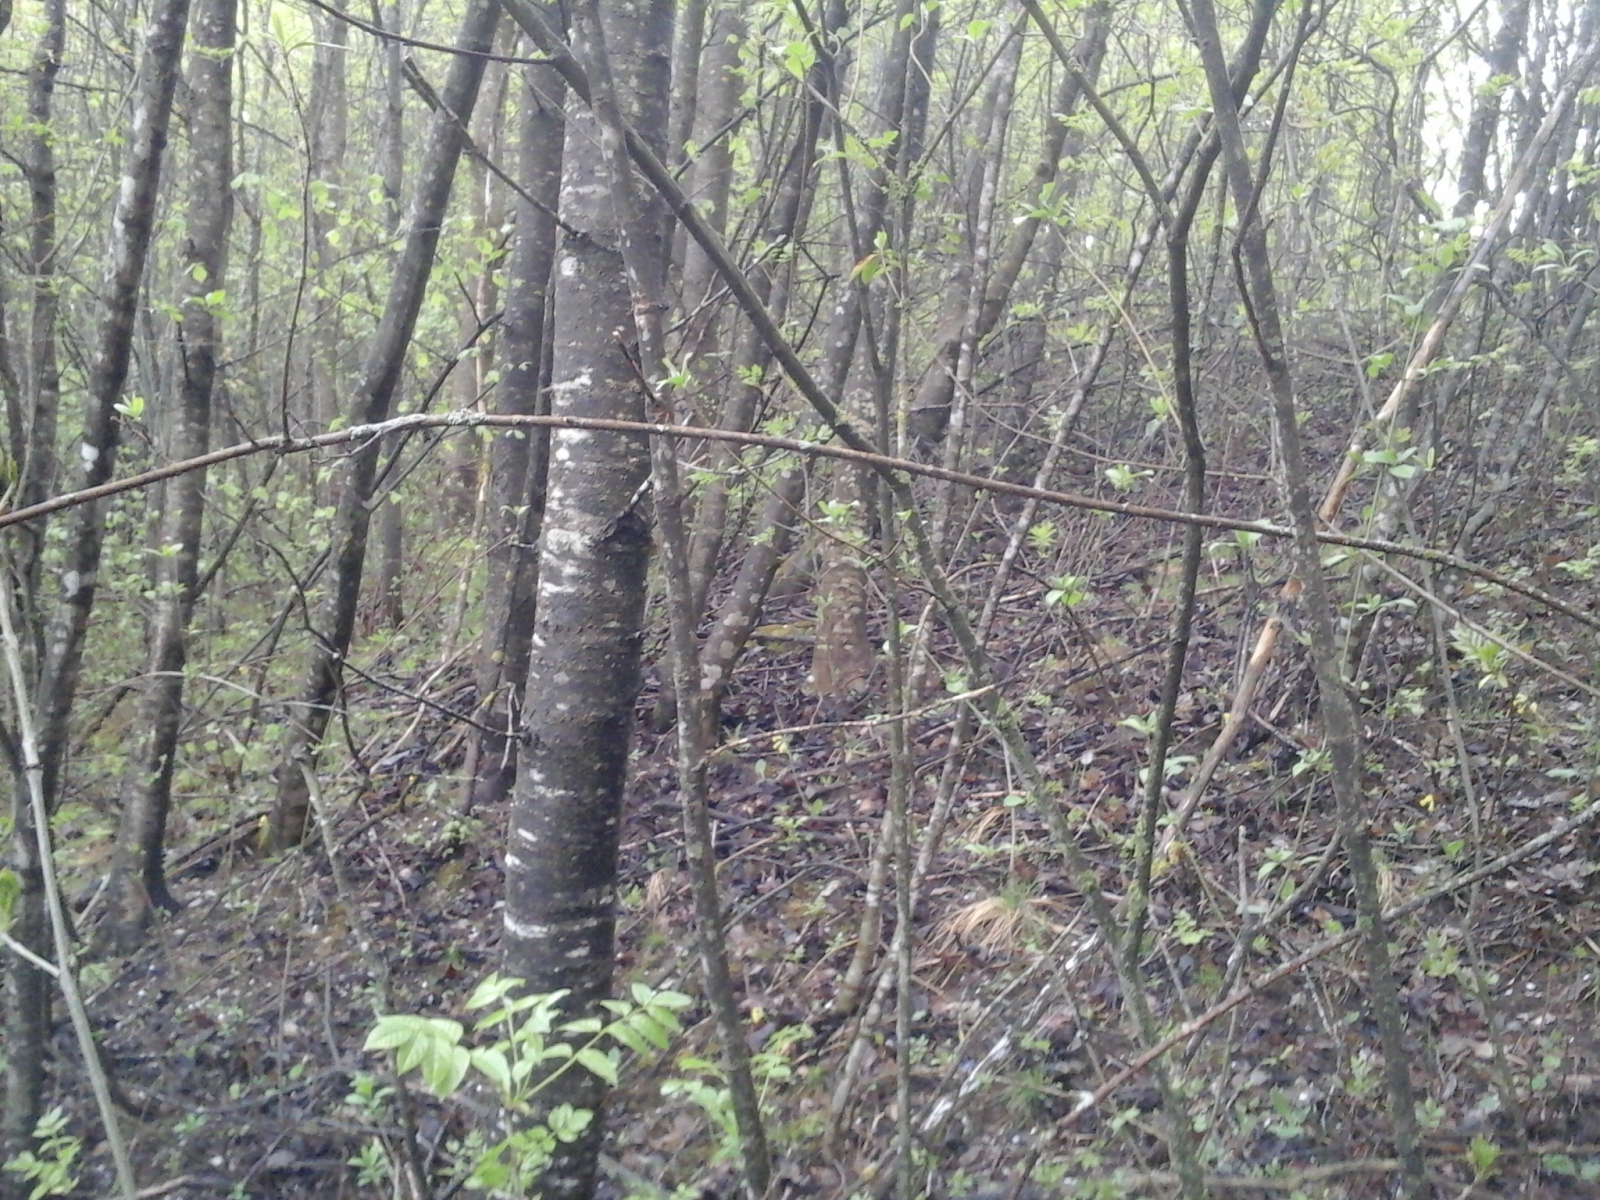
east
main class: Woodland
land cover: Other mixed woodland
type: mesophytic deciduous forest
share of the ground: > 75 %
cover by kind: broadleaved forest trees 75 %, coniferous forest trees 25 %
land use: Forestry
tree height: > 5 m
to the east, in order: Other mixed woodland; Spruce dominated coniferous woodland; Paved roads, cycling and walking lanes; Grassland without tree/shrub cover; Abandoned hedges; Grassland without tree/shrub cover; Tracks; Grassland without tree/shrub cover; Abandoned hedges; Grassland without tree/shrub cover
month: May
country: IT
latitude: 46.4353
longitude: 11.1309
